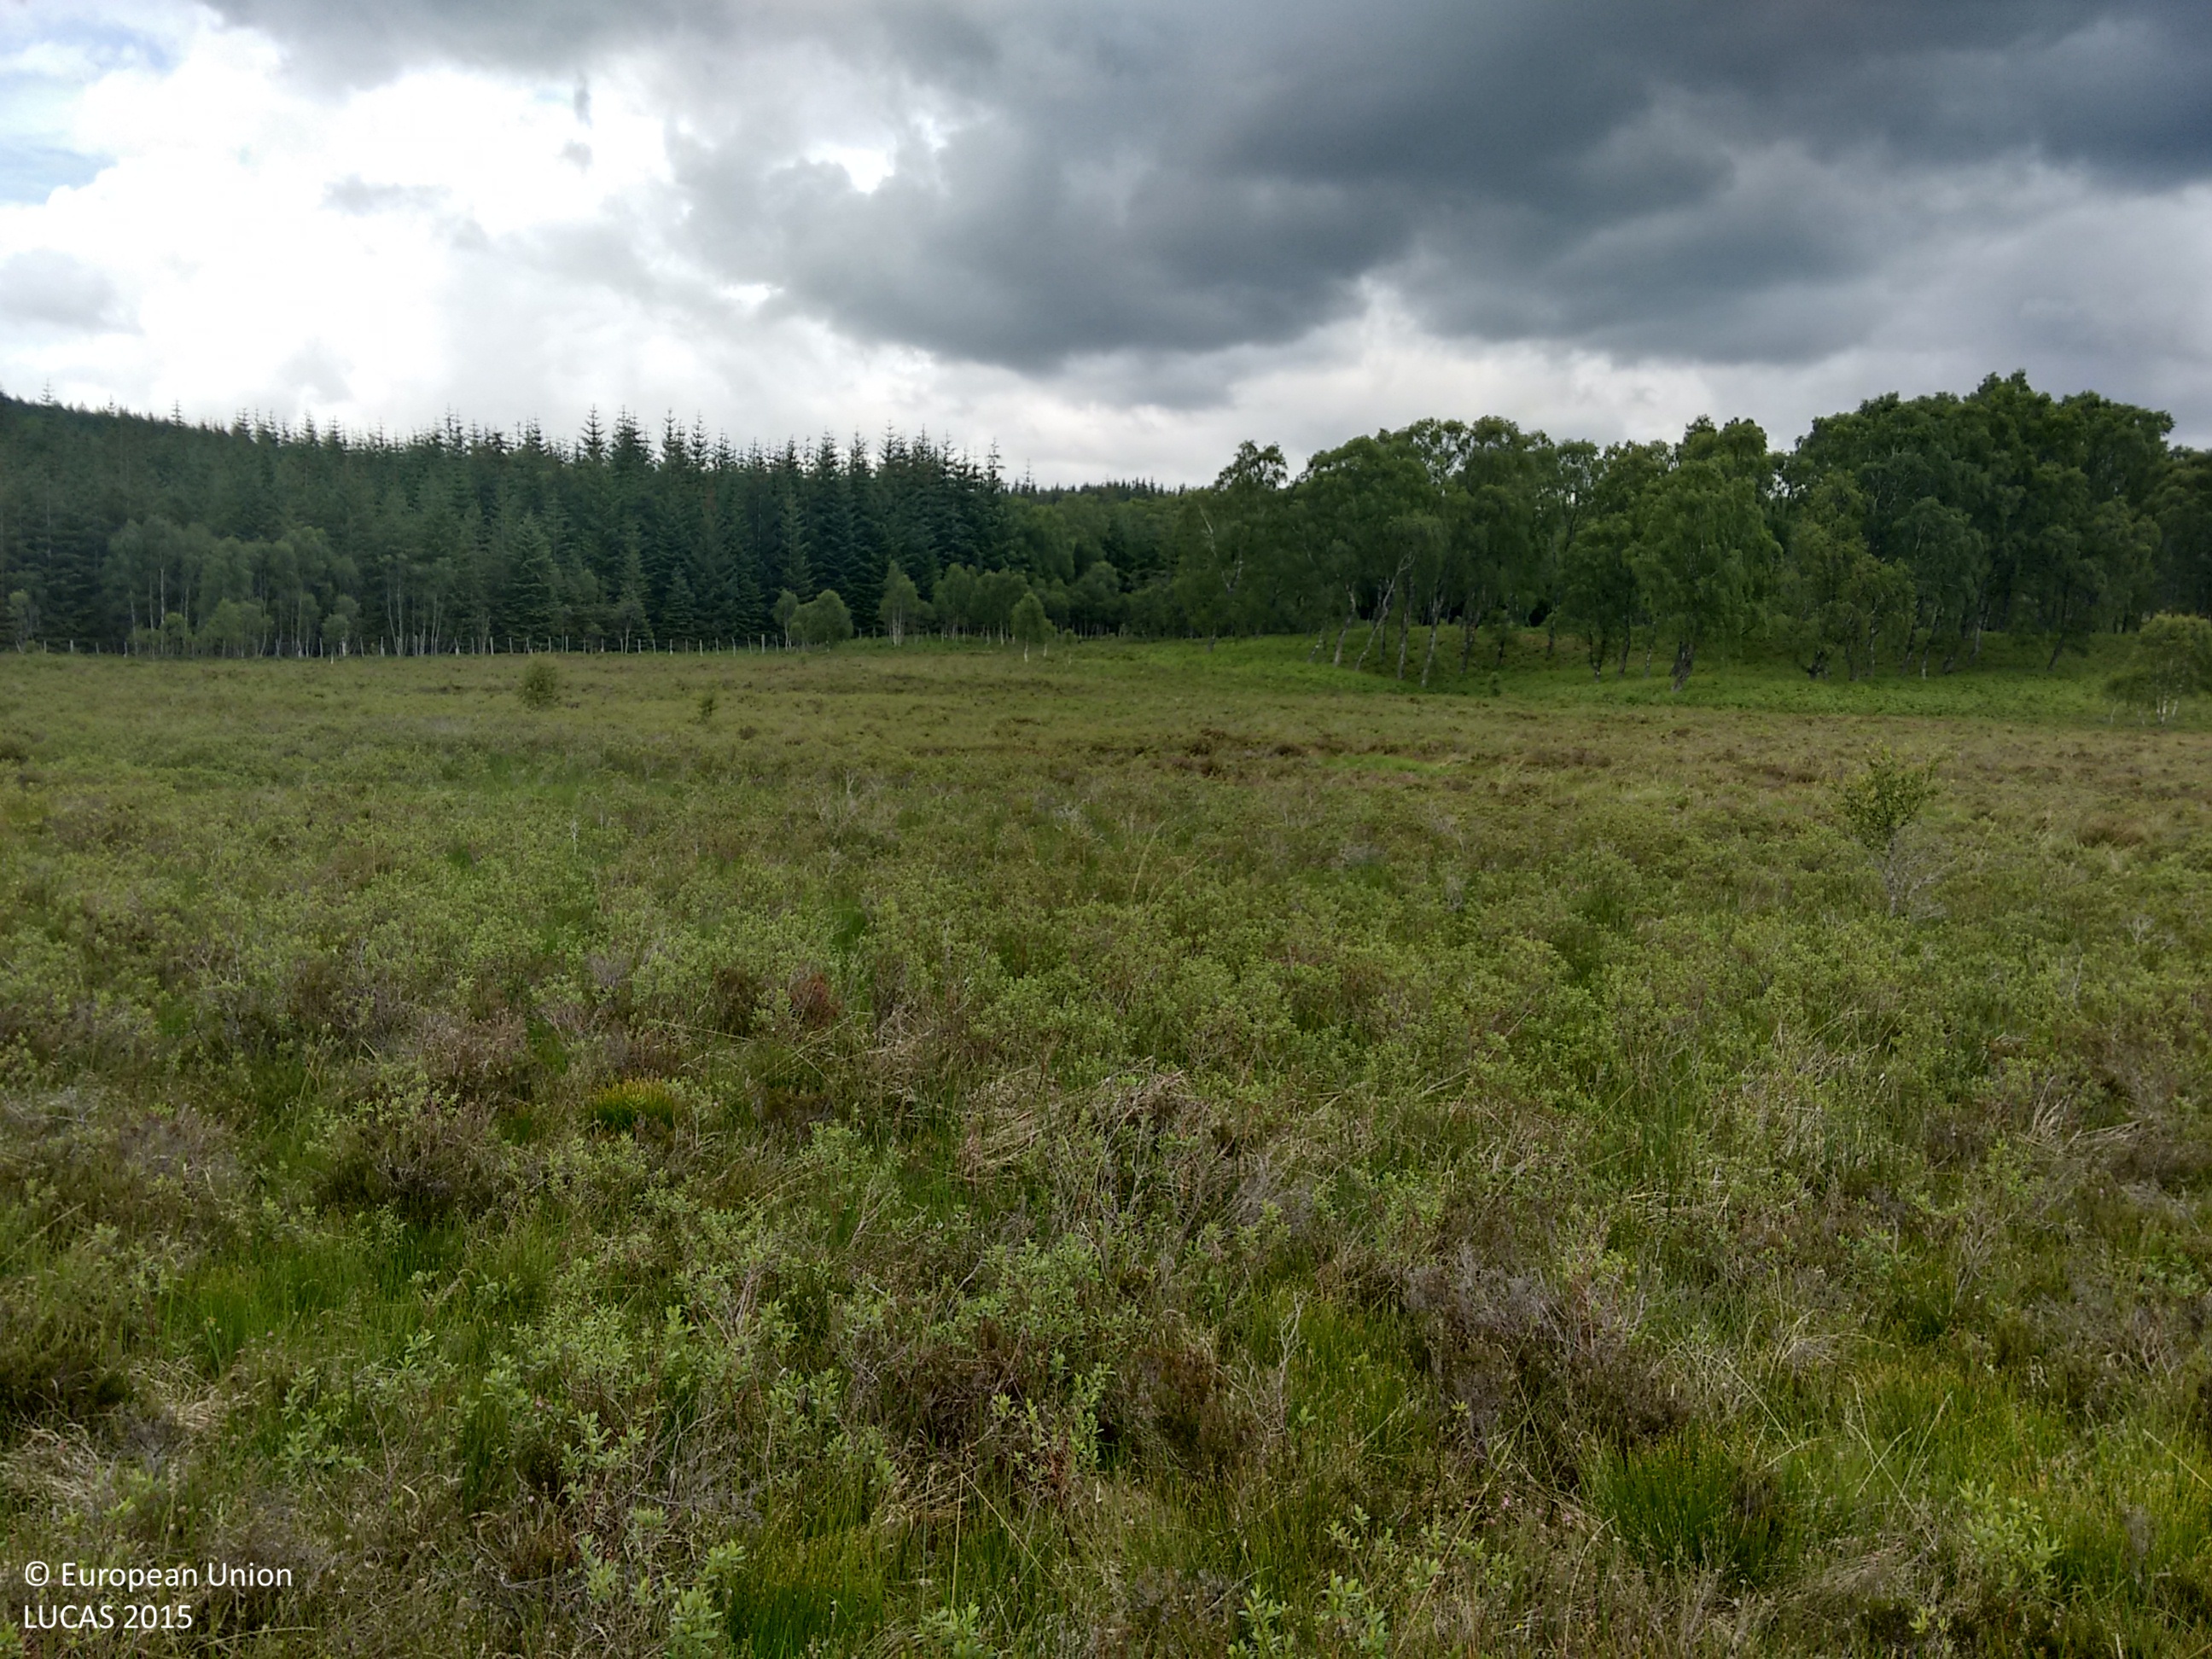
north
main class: Shrubland
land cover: Shrubland without tree cover
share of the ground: > 75 %
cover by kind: shrubs 65 %, herbaceous plants 25 %, lichens and mosses 10 %
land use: Semi-natural and natural areas not in use
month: July
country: GB
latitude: 56.6969
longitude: -4.3145
